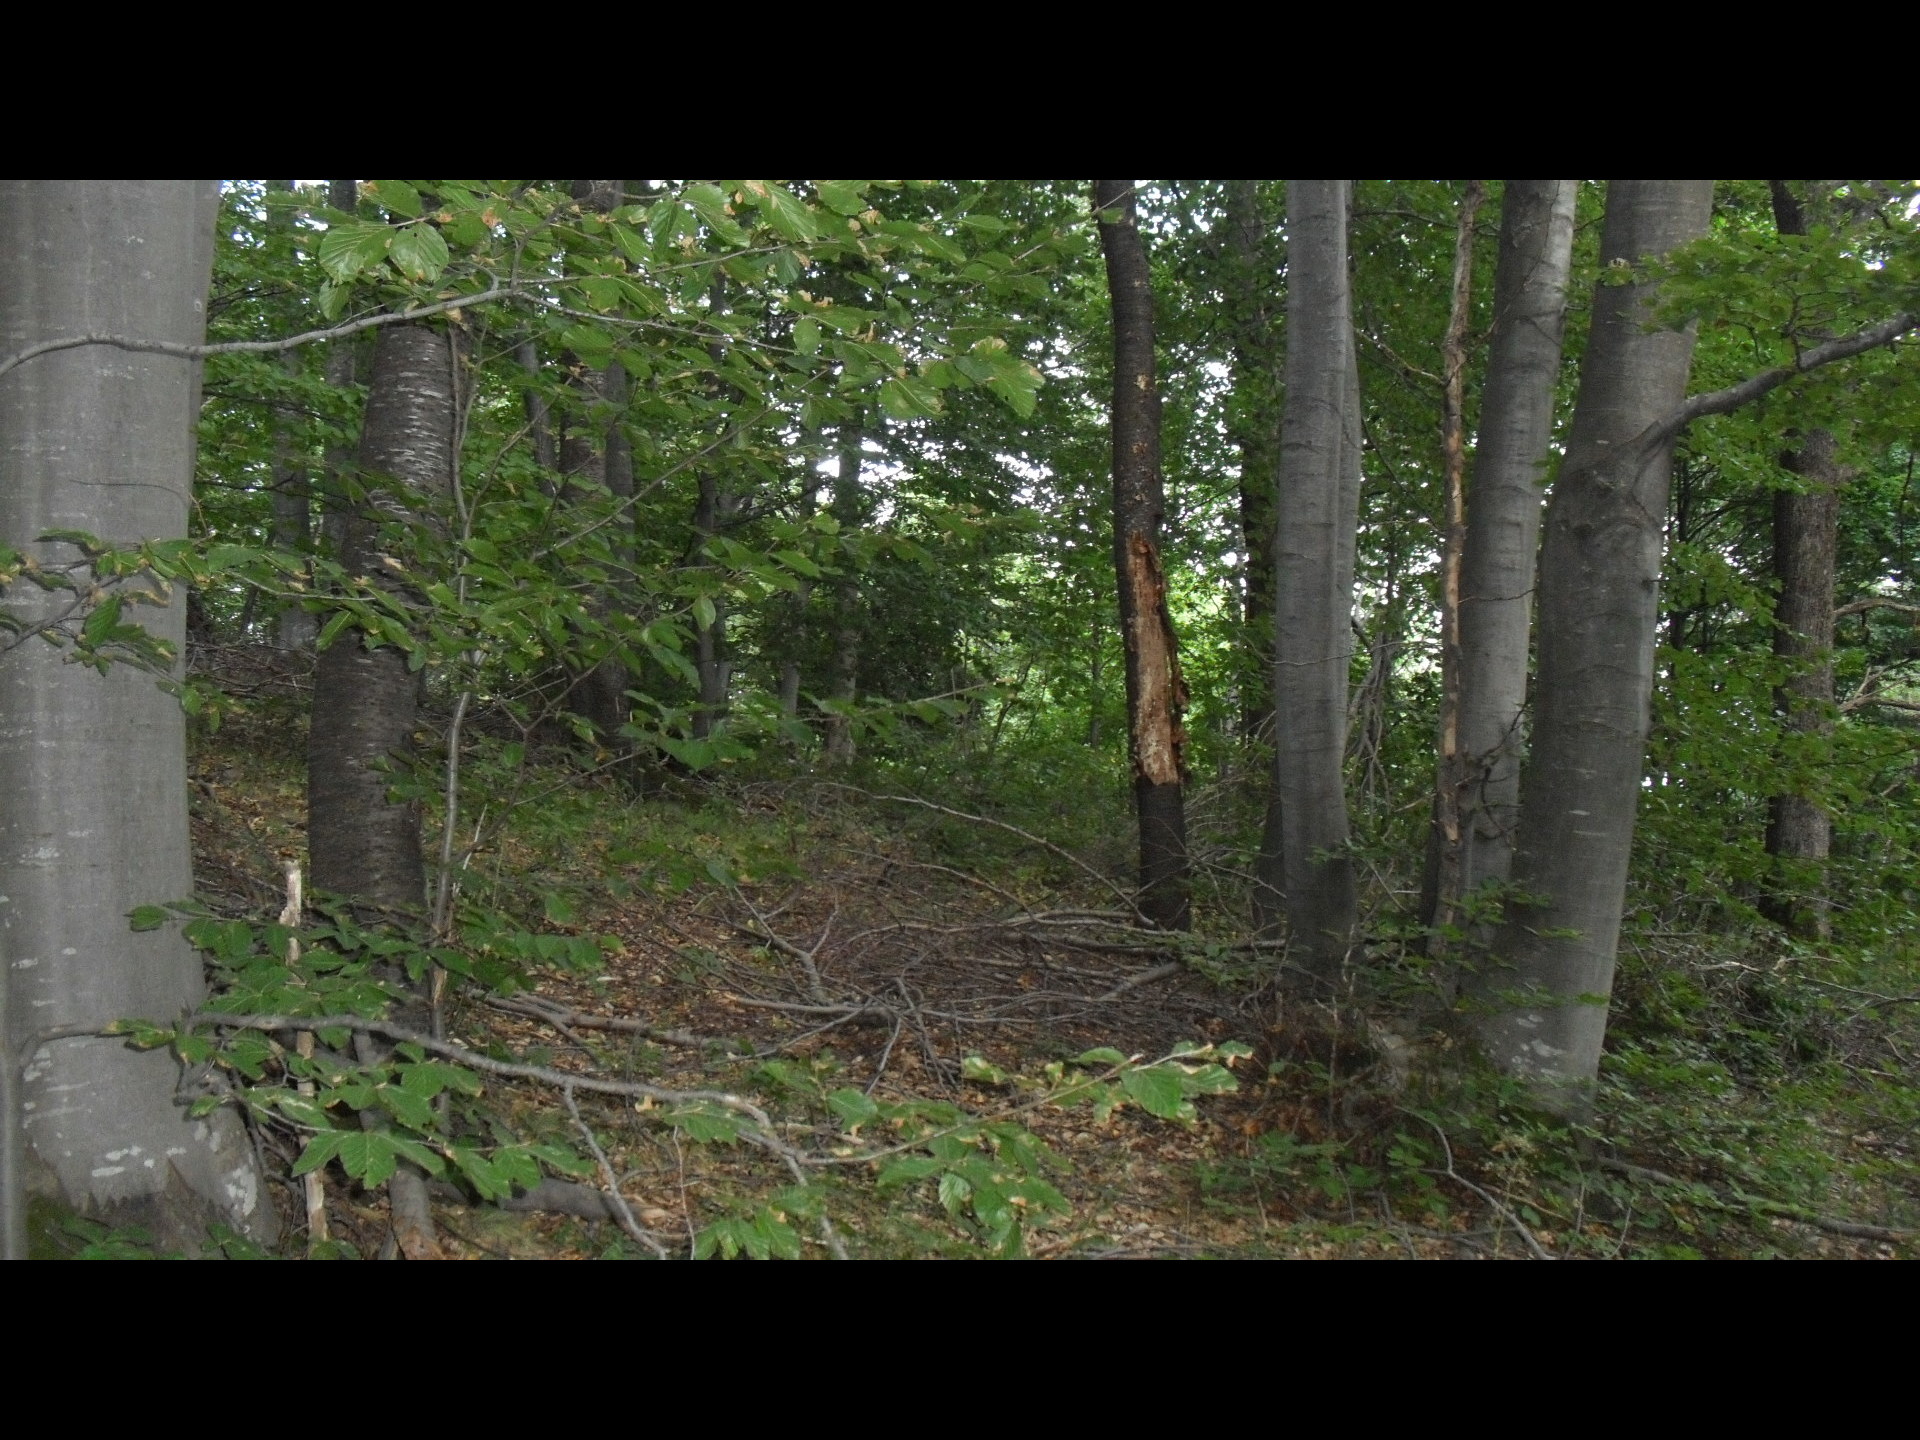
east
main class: Woodland
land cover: Broadleaved woodland
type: beech forest
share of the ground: > 75 %
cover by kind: broadleaved forest trees 95 %, unconsolidated bare surface 5 %
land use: Forestry
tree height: > 5 m
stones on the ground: < 10 %
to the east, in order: Broadleaved woodland; Tracks; Broadleaved woodland
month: August
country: BG
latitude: 43.2450
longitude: 23.0784
